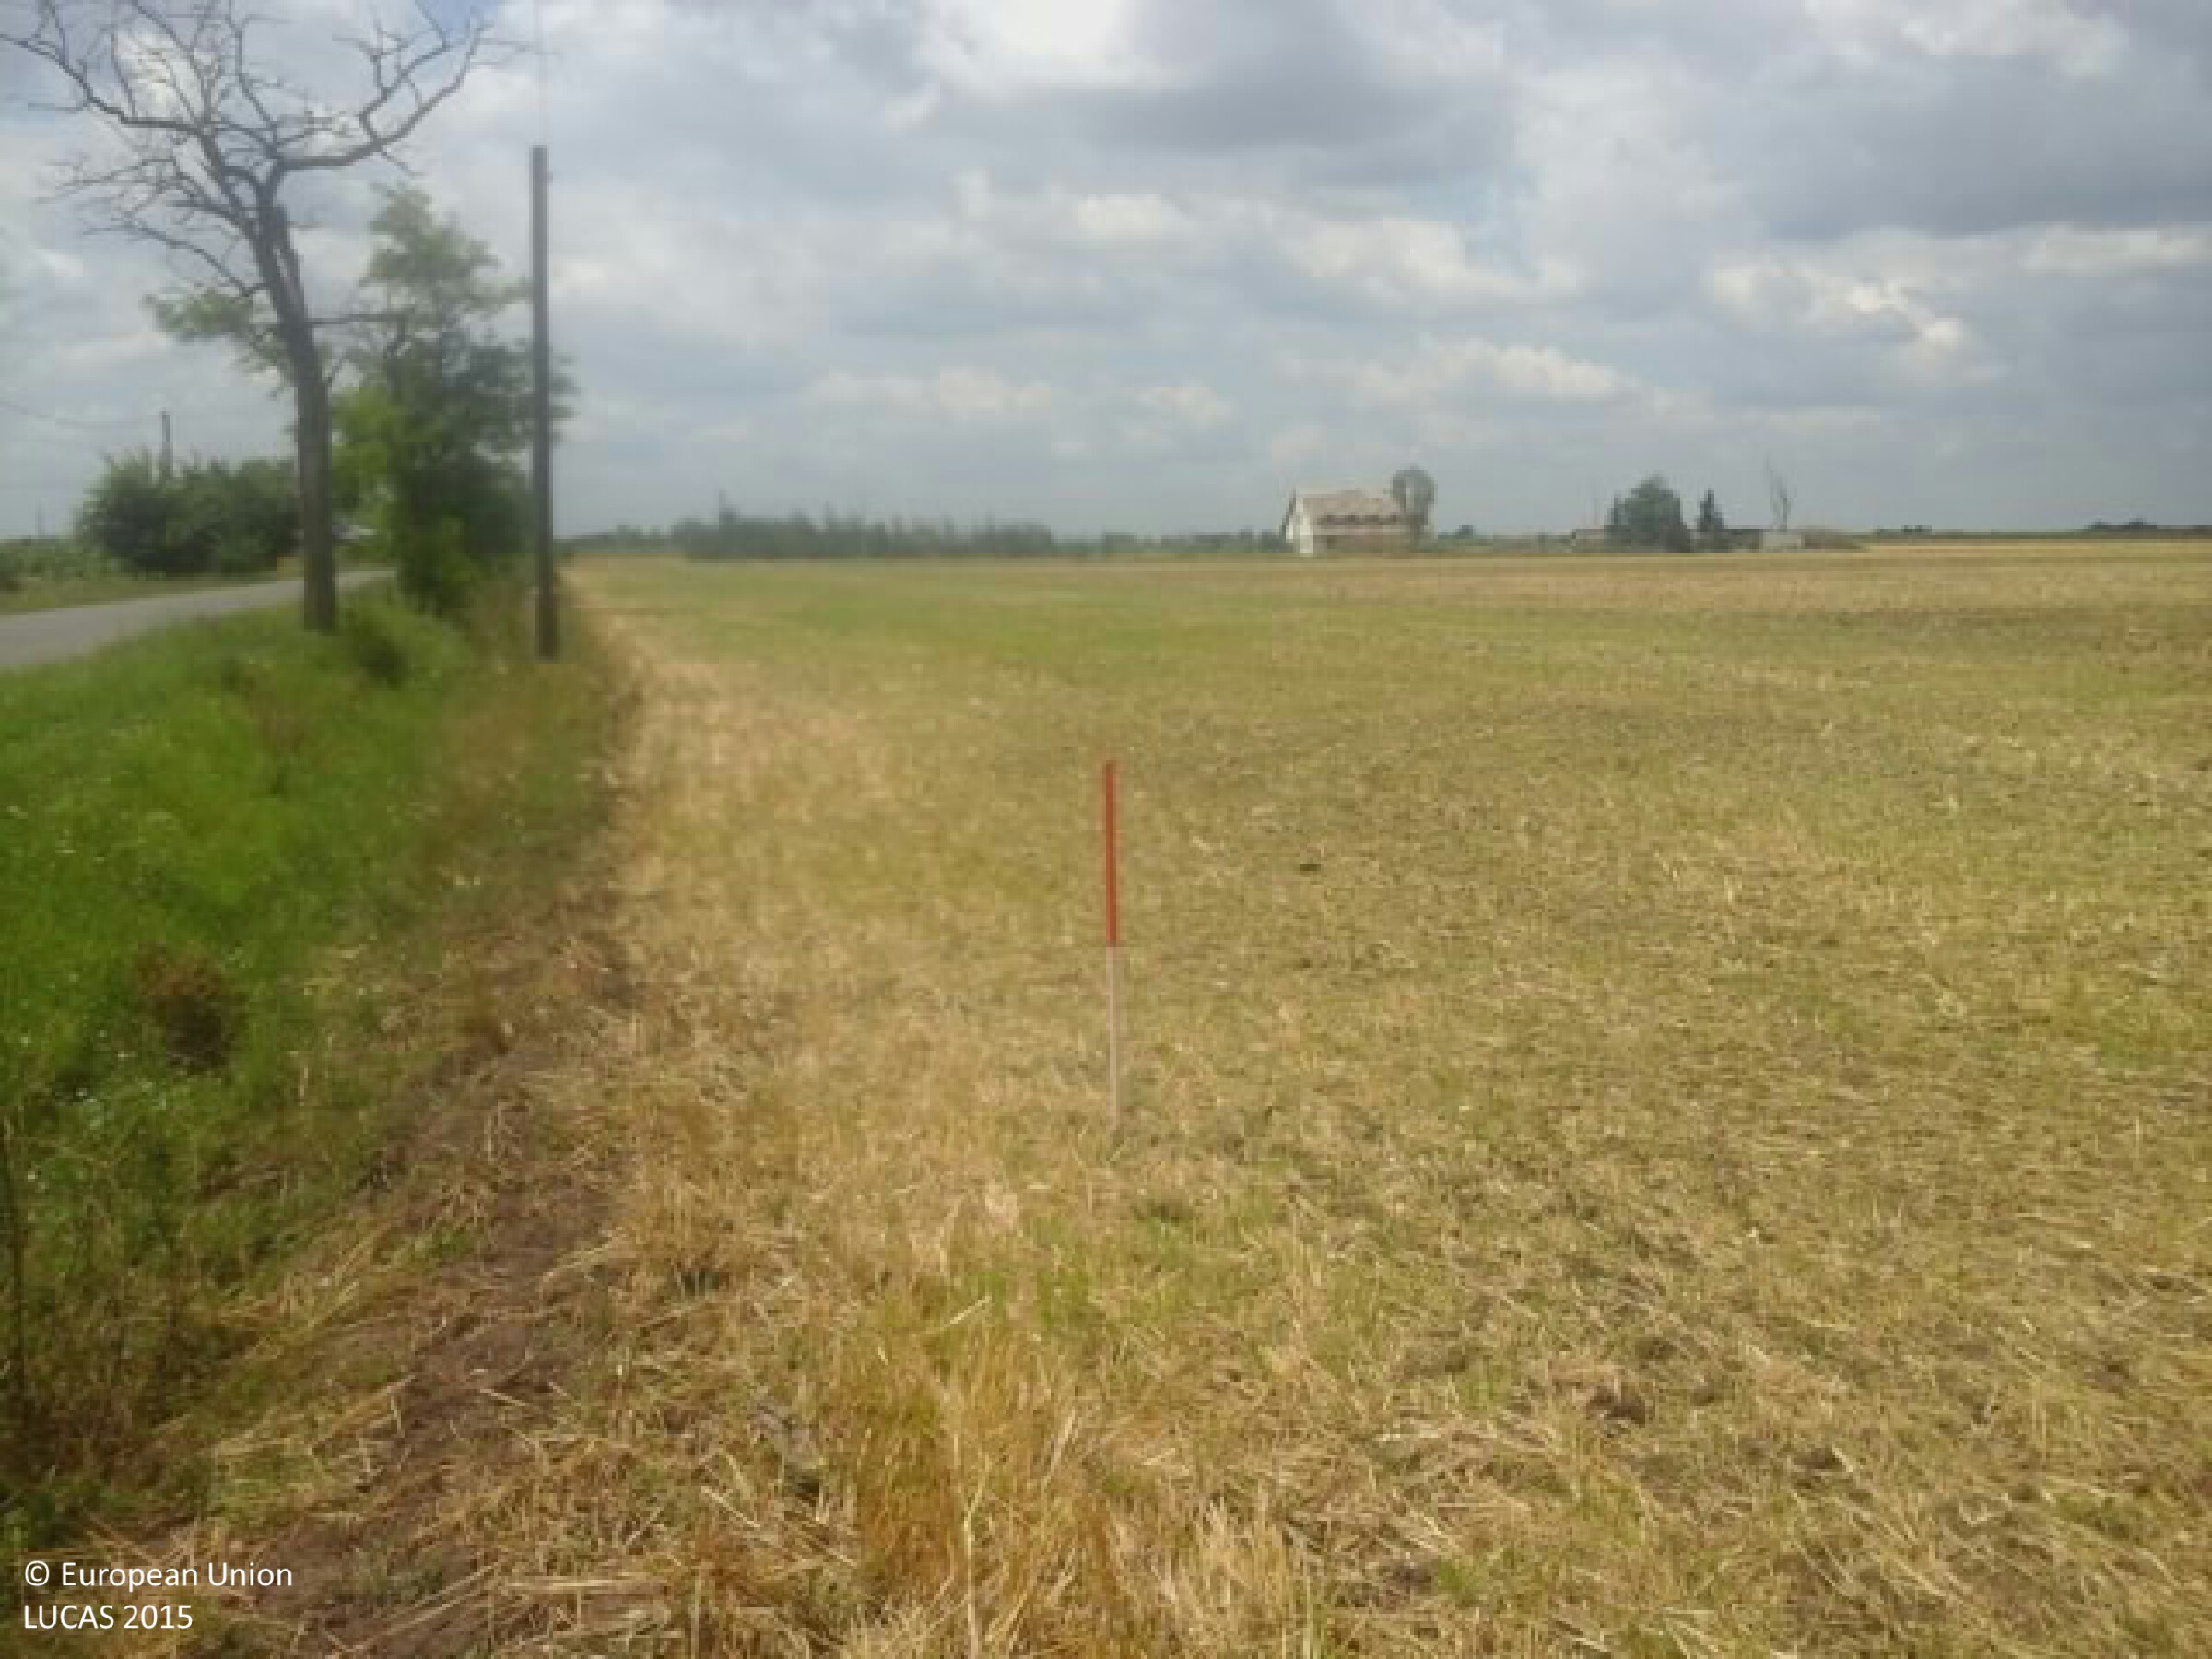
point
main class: Cropland
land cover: Barley
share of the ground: 10 - 25 %
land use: Agriculture (excluding fallow land and kitchen gardens)
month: July
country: HU
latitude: 46.4877
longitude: 20.6716
